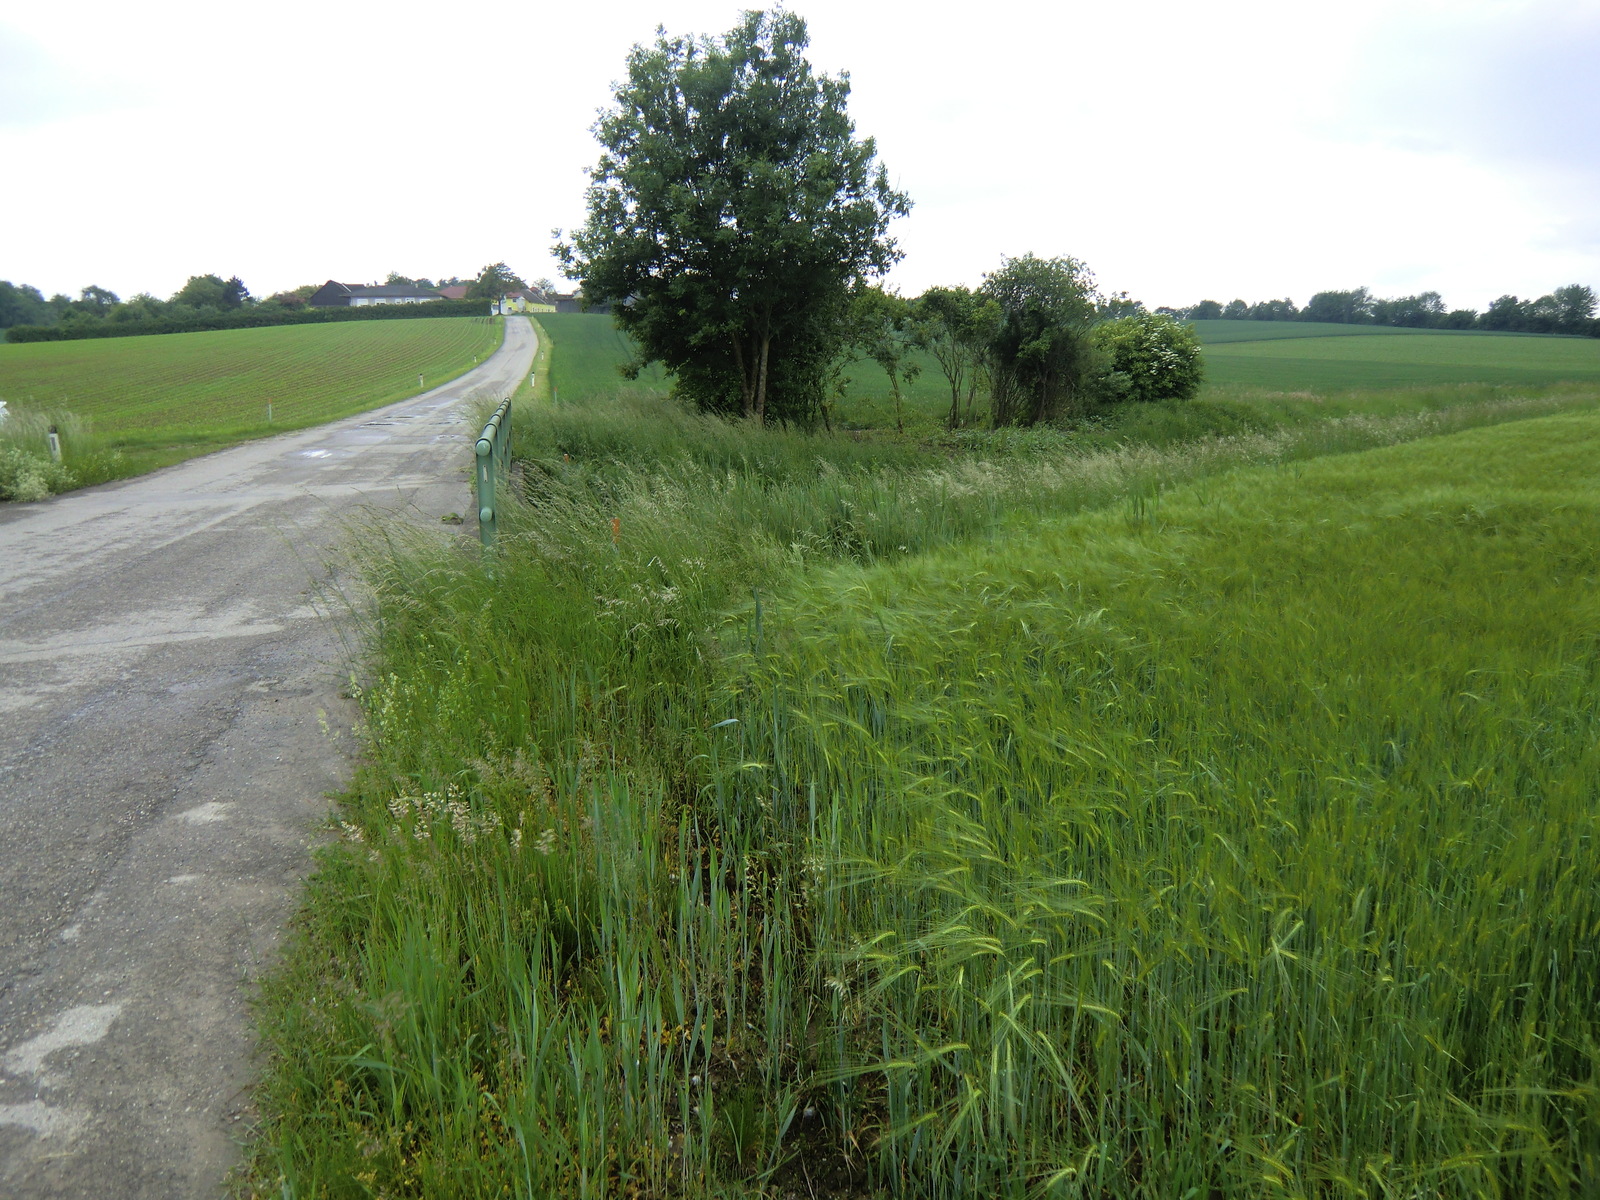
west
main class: Cropland
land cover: Barley
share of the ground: > 75 %
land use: Agriculture (excluding fallow land and kitchen gardens)
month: May
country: AT
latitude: 48.1431
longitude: 15.4451
